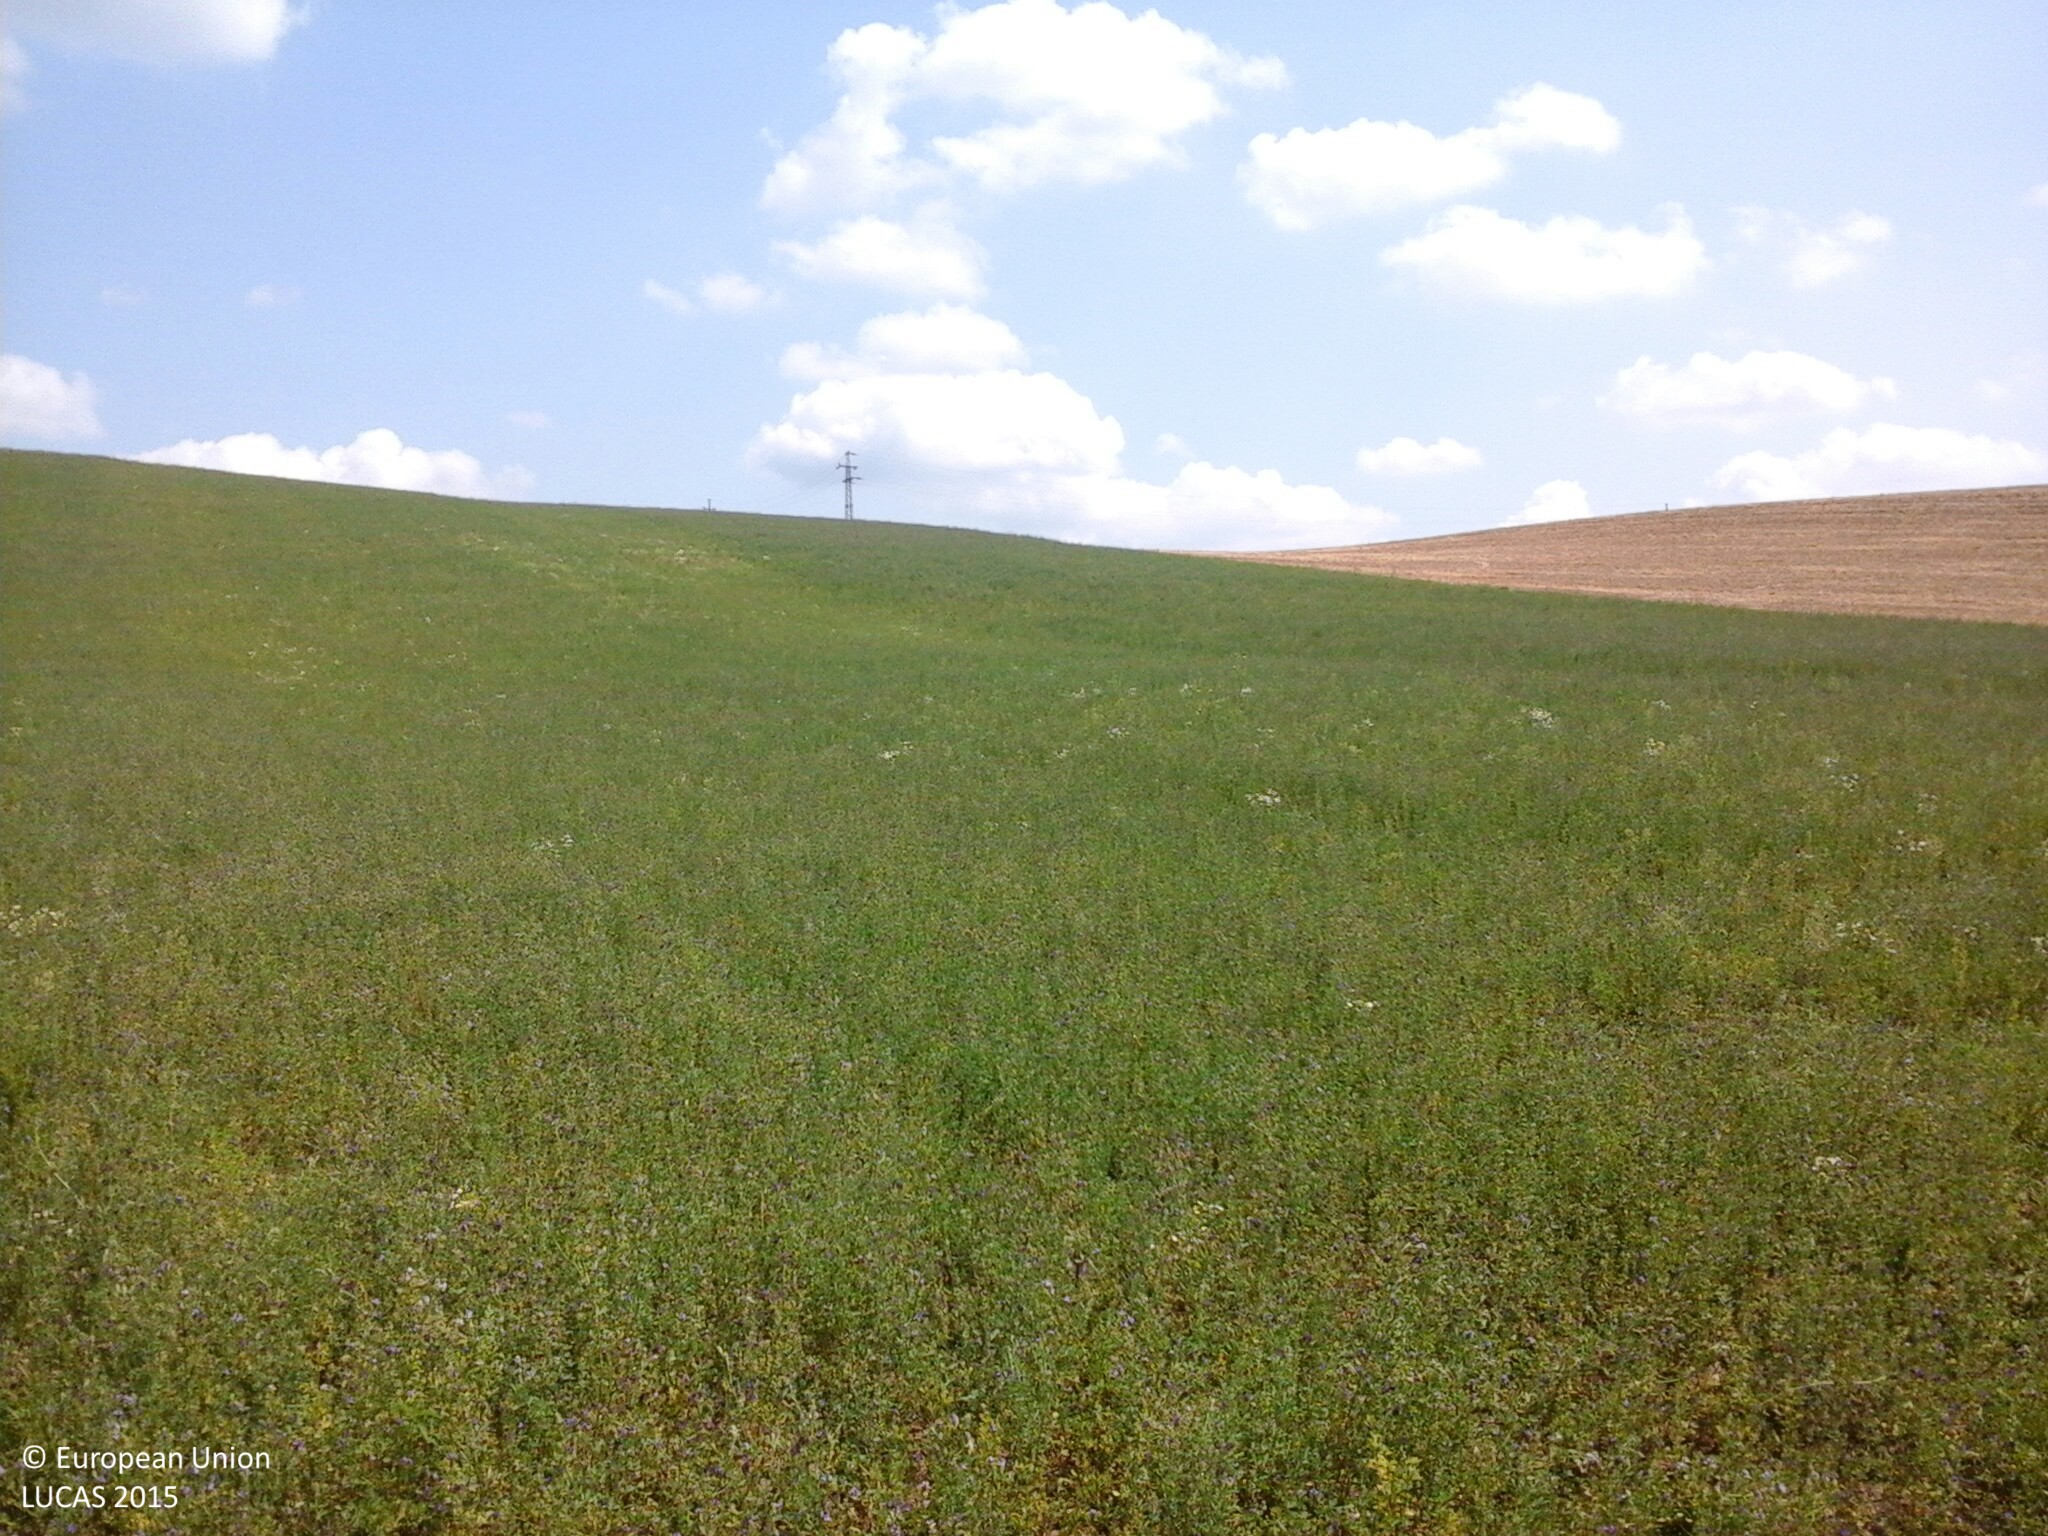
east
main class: Cropland
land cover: Lucerne
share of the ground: > 75 %
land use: Agriculture (excluding fallow land and kitchen gardens)
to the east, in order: Lucerne; Common wheat
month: August
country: HU
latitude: 47.3525
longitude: 18.2593
